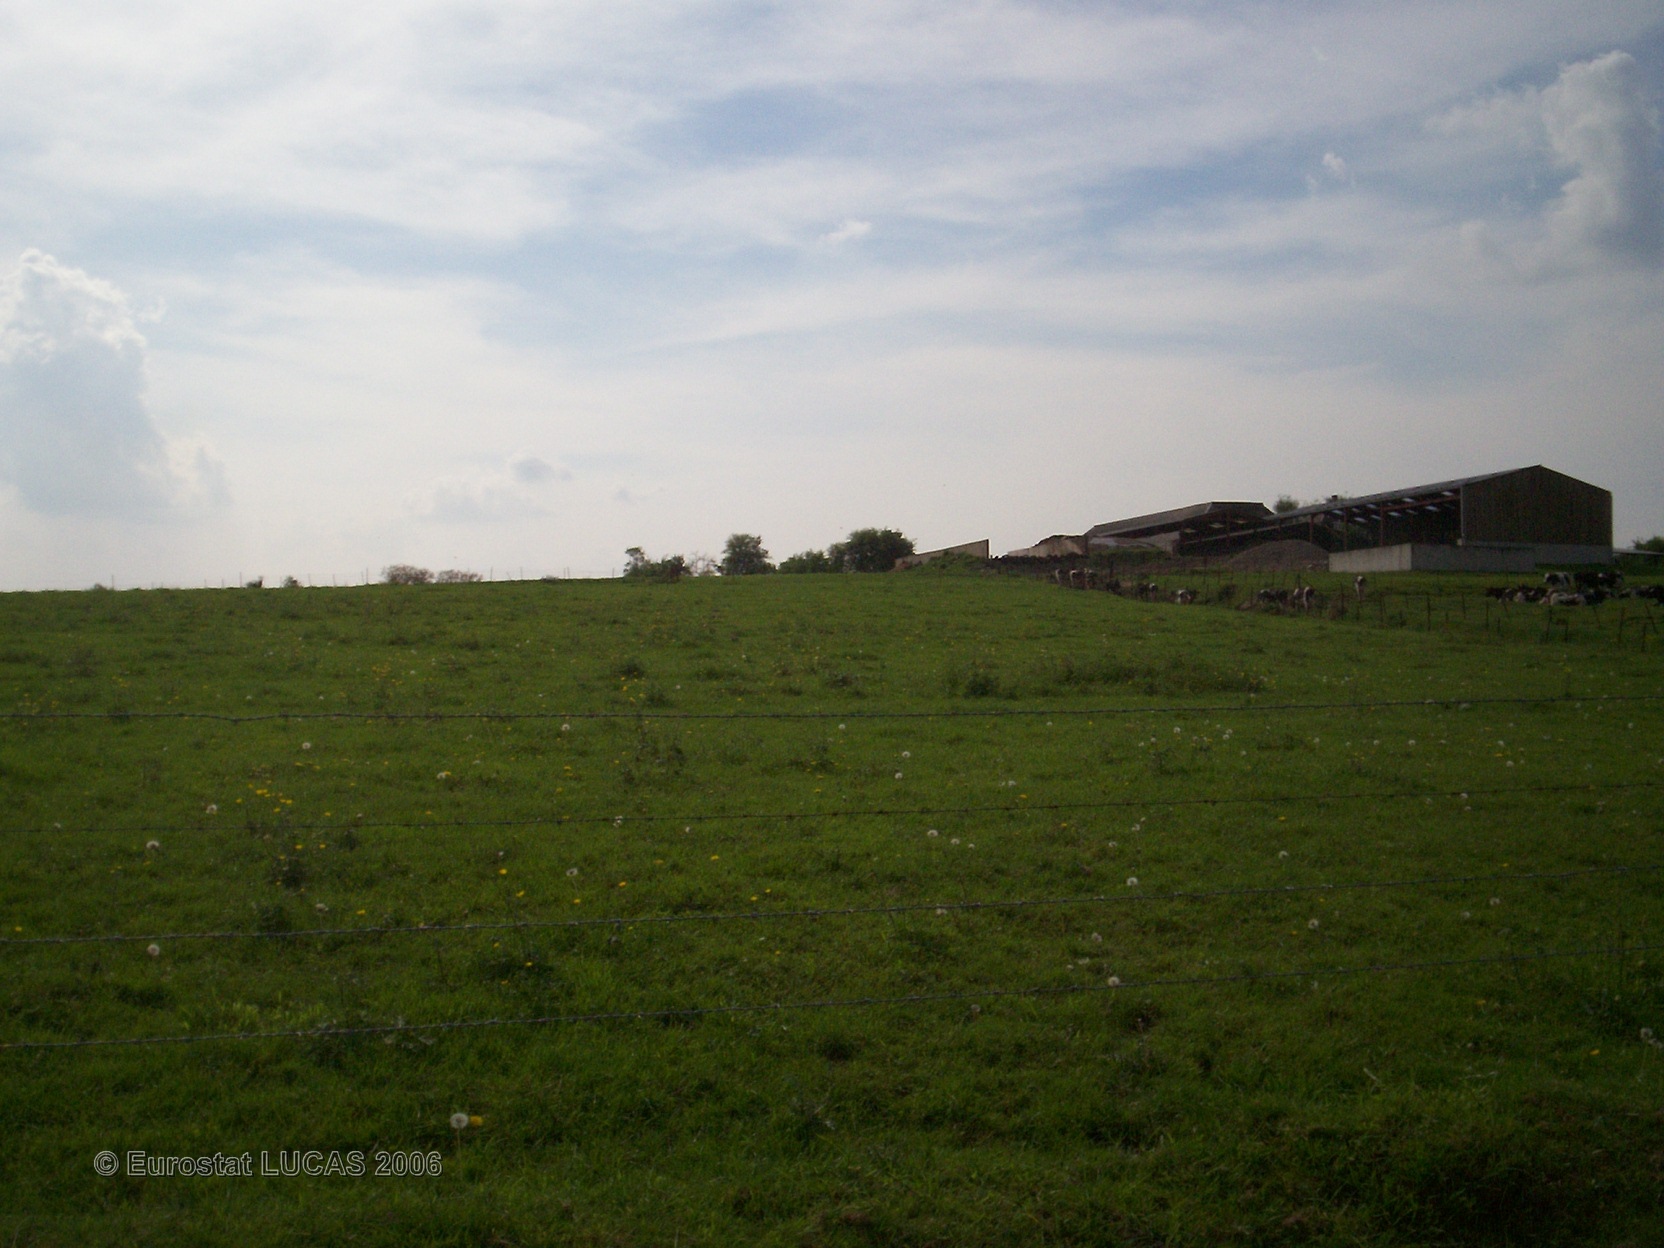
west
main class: Grassland
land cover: Grassland without tree/shrub cover
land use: Agriculture (excluding fallow land and kitchen gardens)
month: May
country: FR
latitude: 49.6273
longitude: 4.3057
